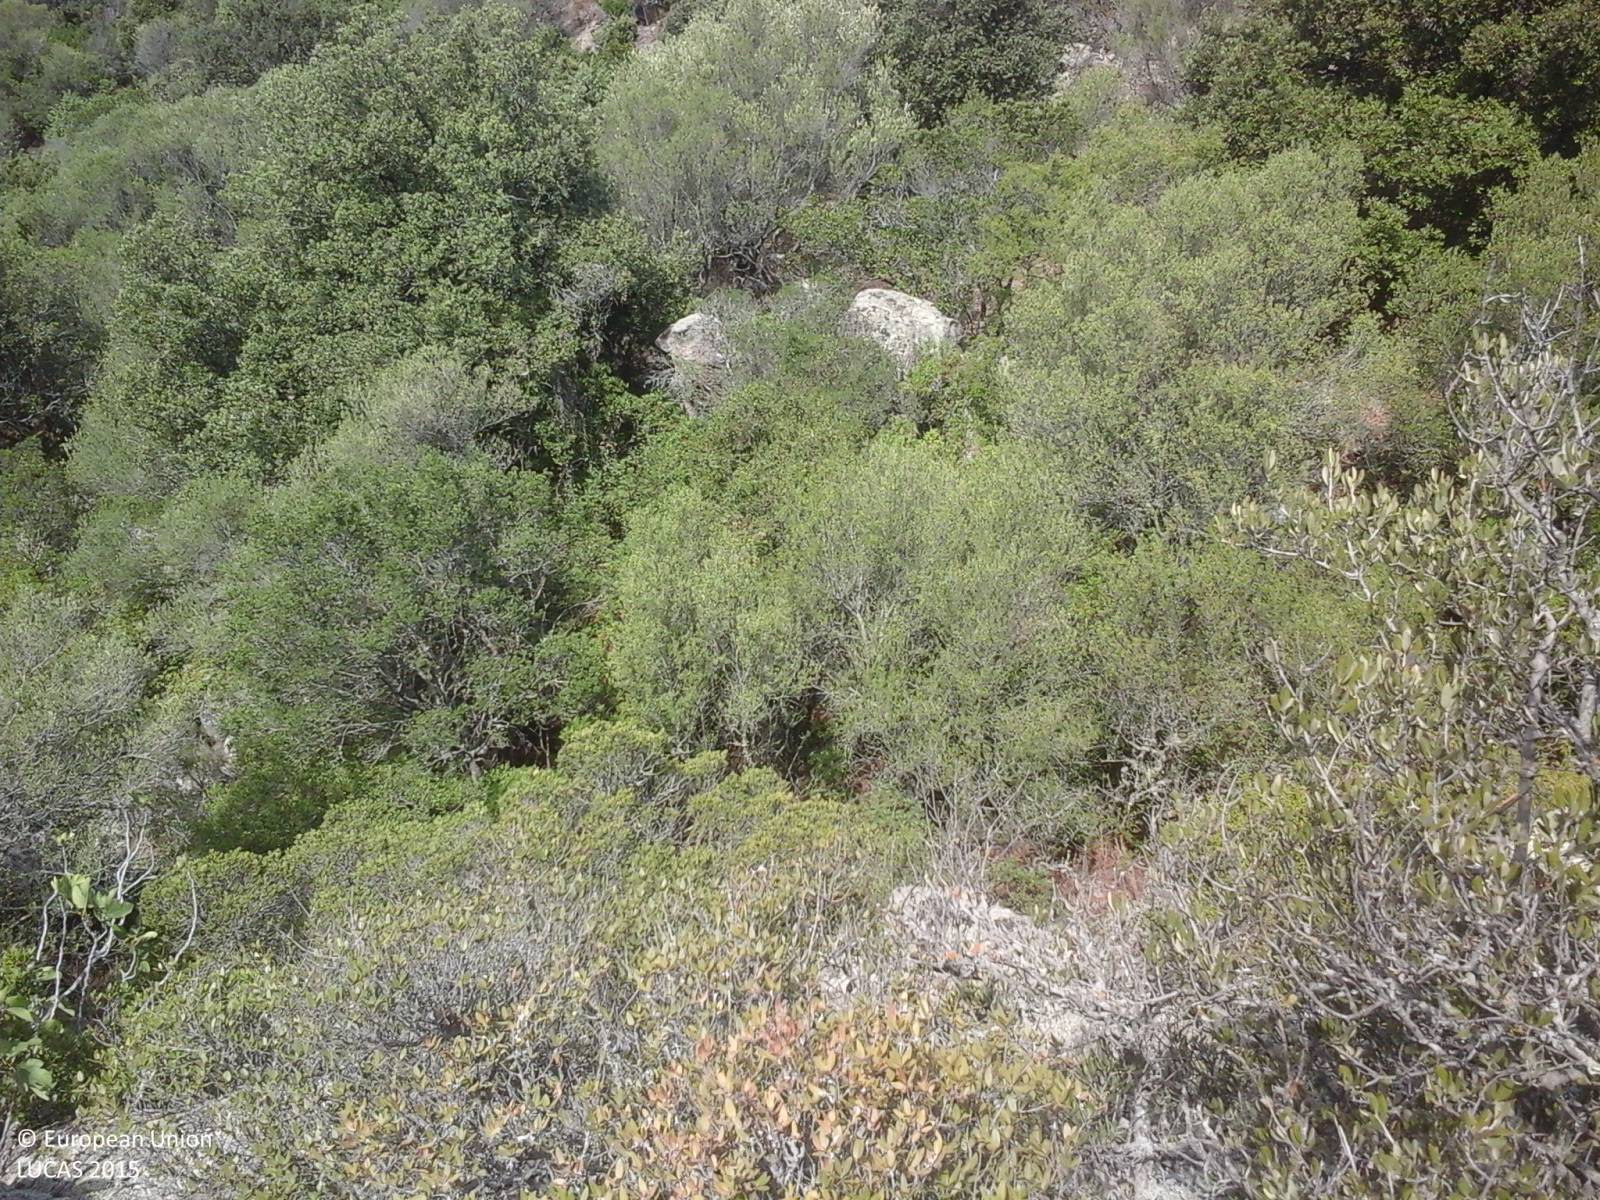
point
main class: Woodland
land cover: Broadleaved woodland
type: broadleaved evergreen forest
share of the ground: > 75 %
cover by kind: broadleaved forest trees 95 %, consolidated bare surface 5 %
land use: Semi-natural and natural areas not in use
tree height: > 5 m
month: July
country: IT
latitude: 40.8990
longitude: 9.4211
